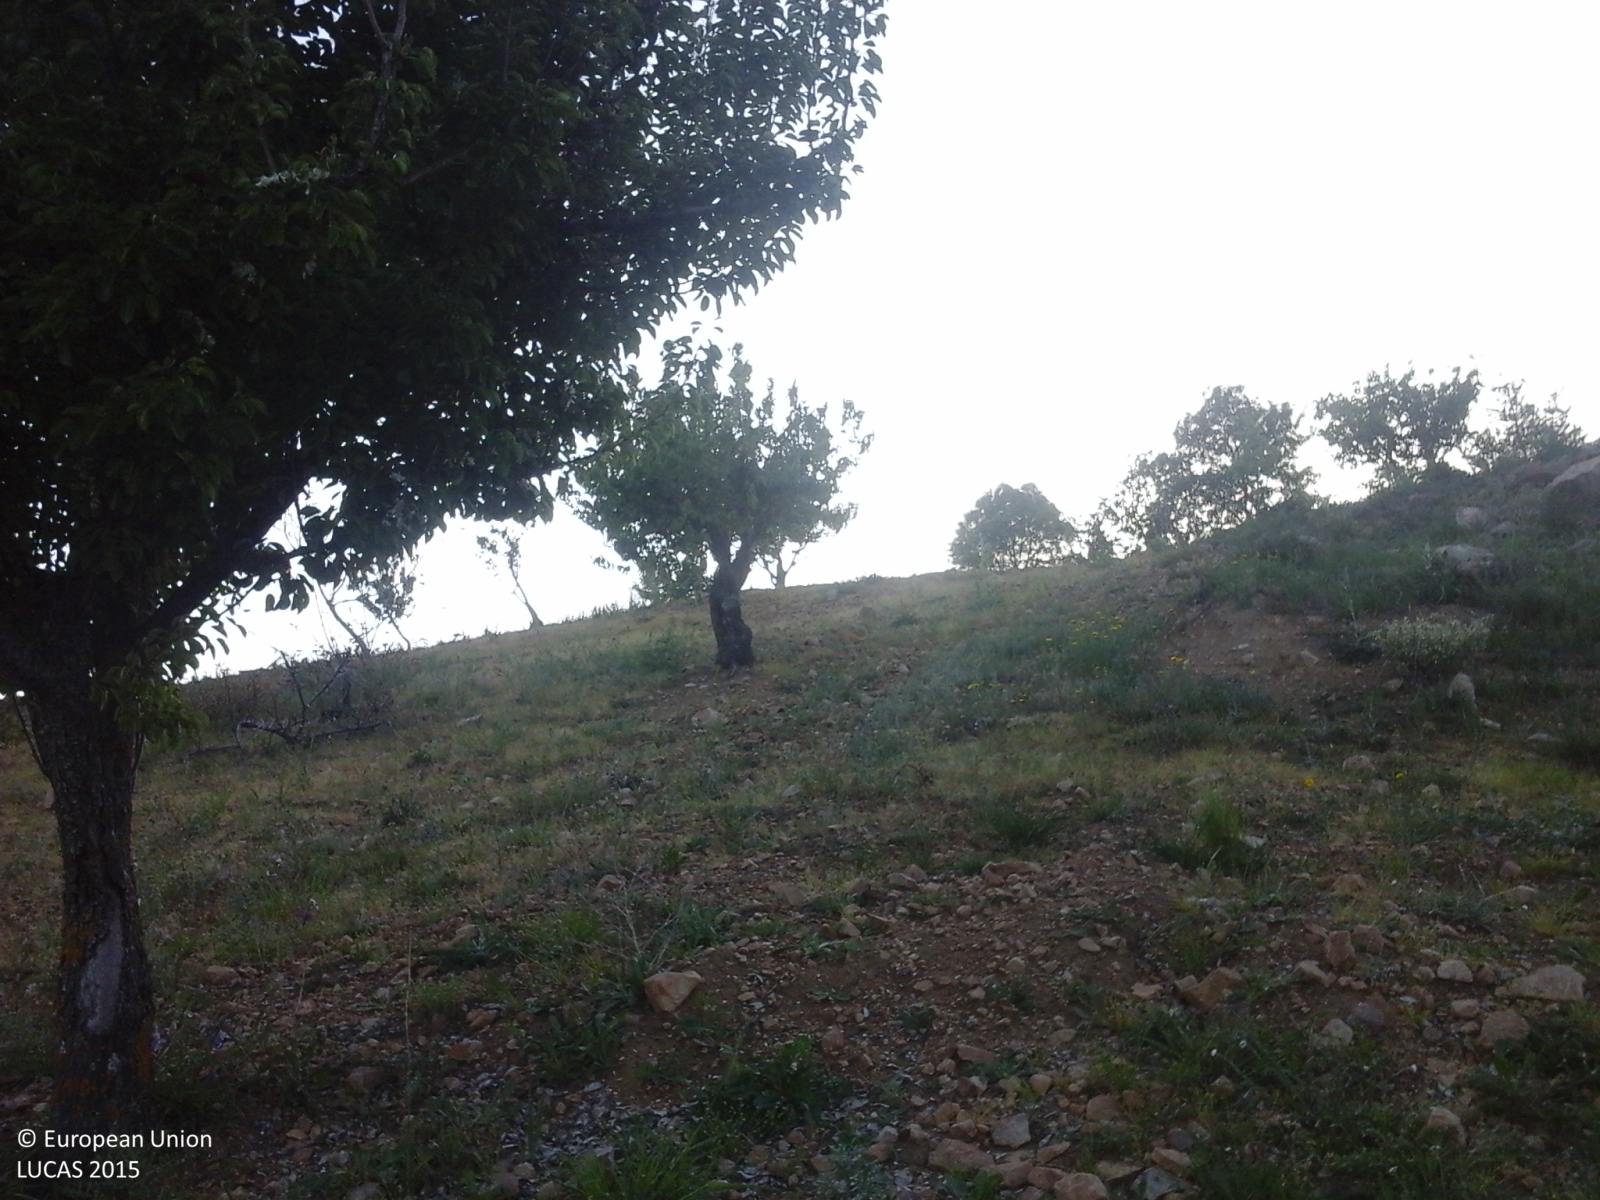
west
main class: Cropland
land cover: Pear fruit
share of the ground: 25 - 50 %
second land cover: Spontaneously vegetated surfaces
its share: > 75 %
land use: Agriculture (excluding fallow land and kitchen gardens)
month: May
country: IT
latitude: 37.8210
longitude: 14.1398
